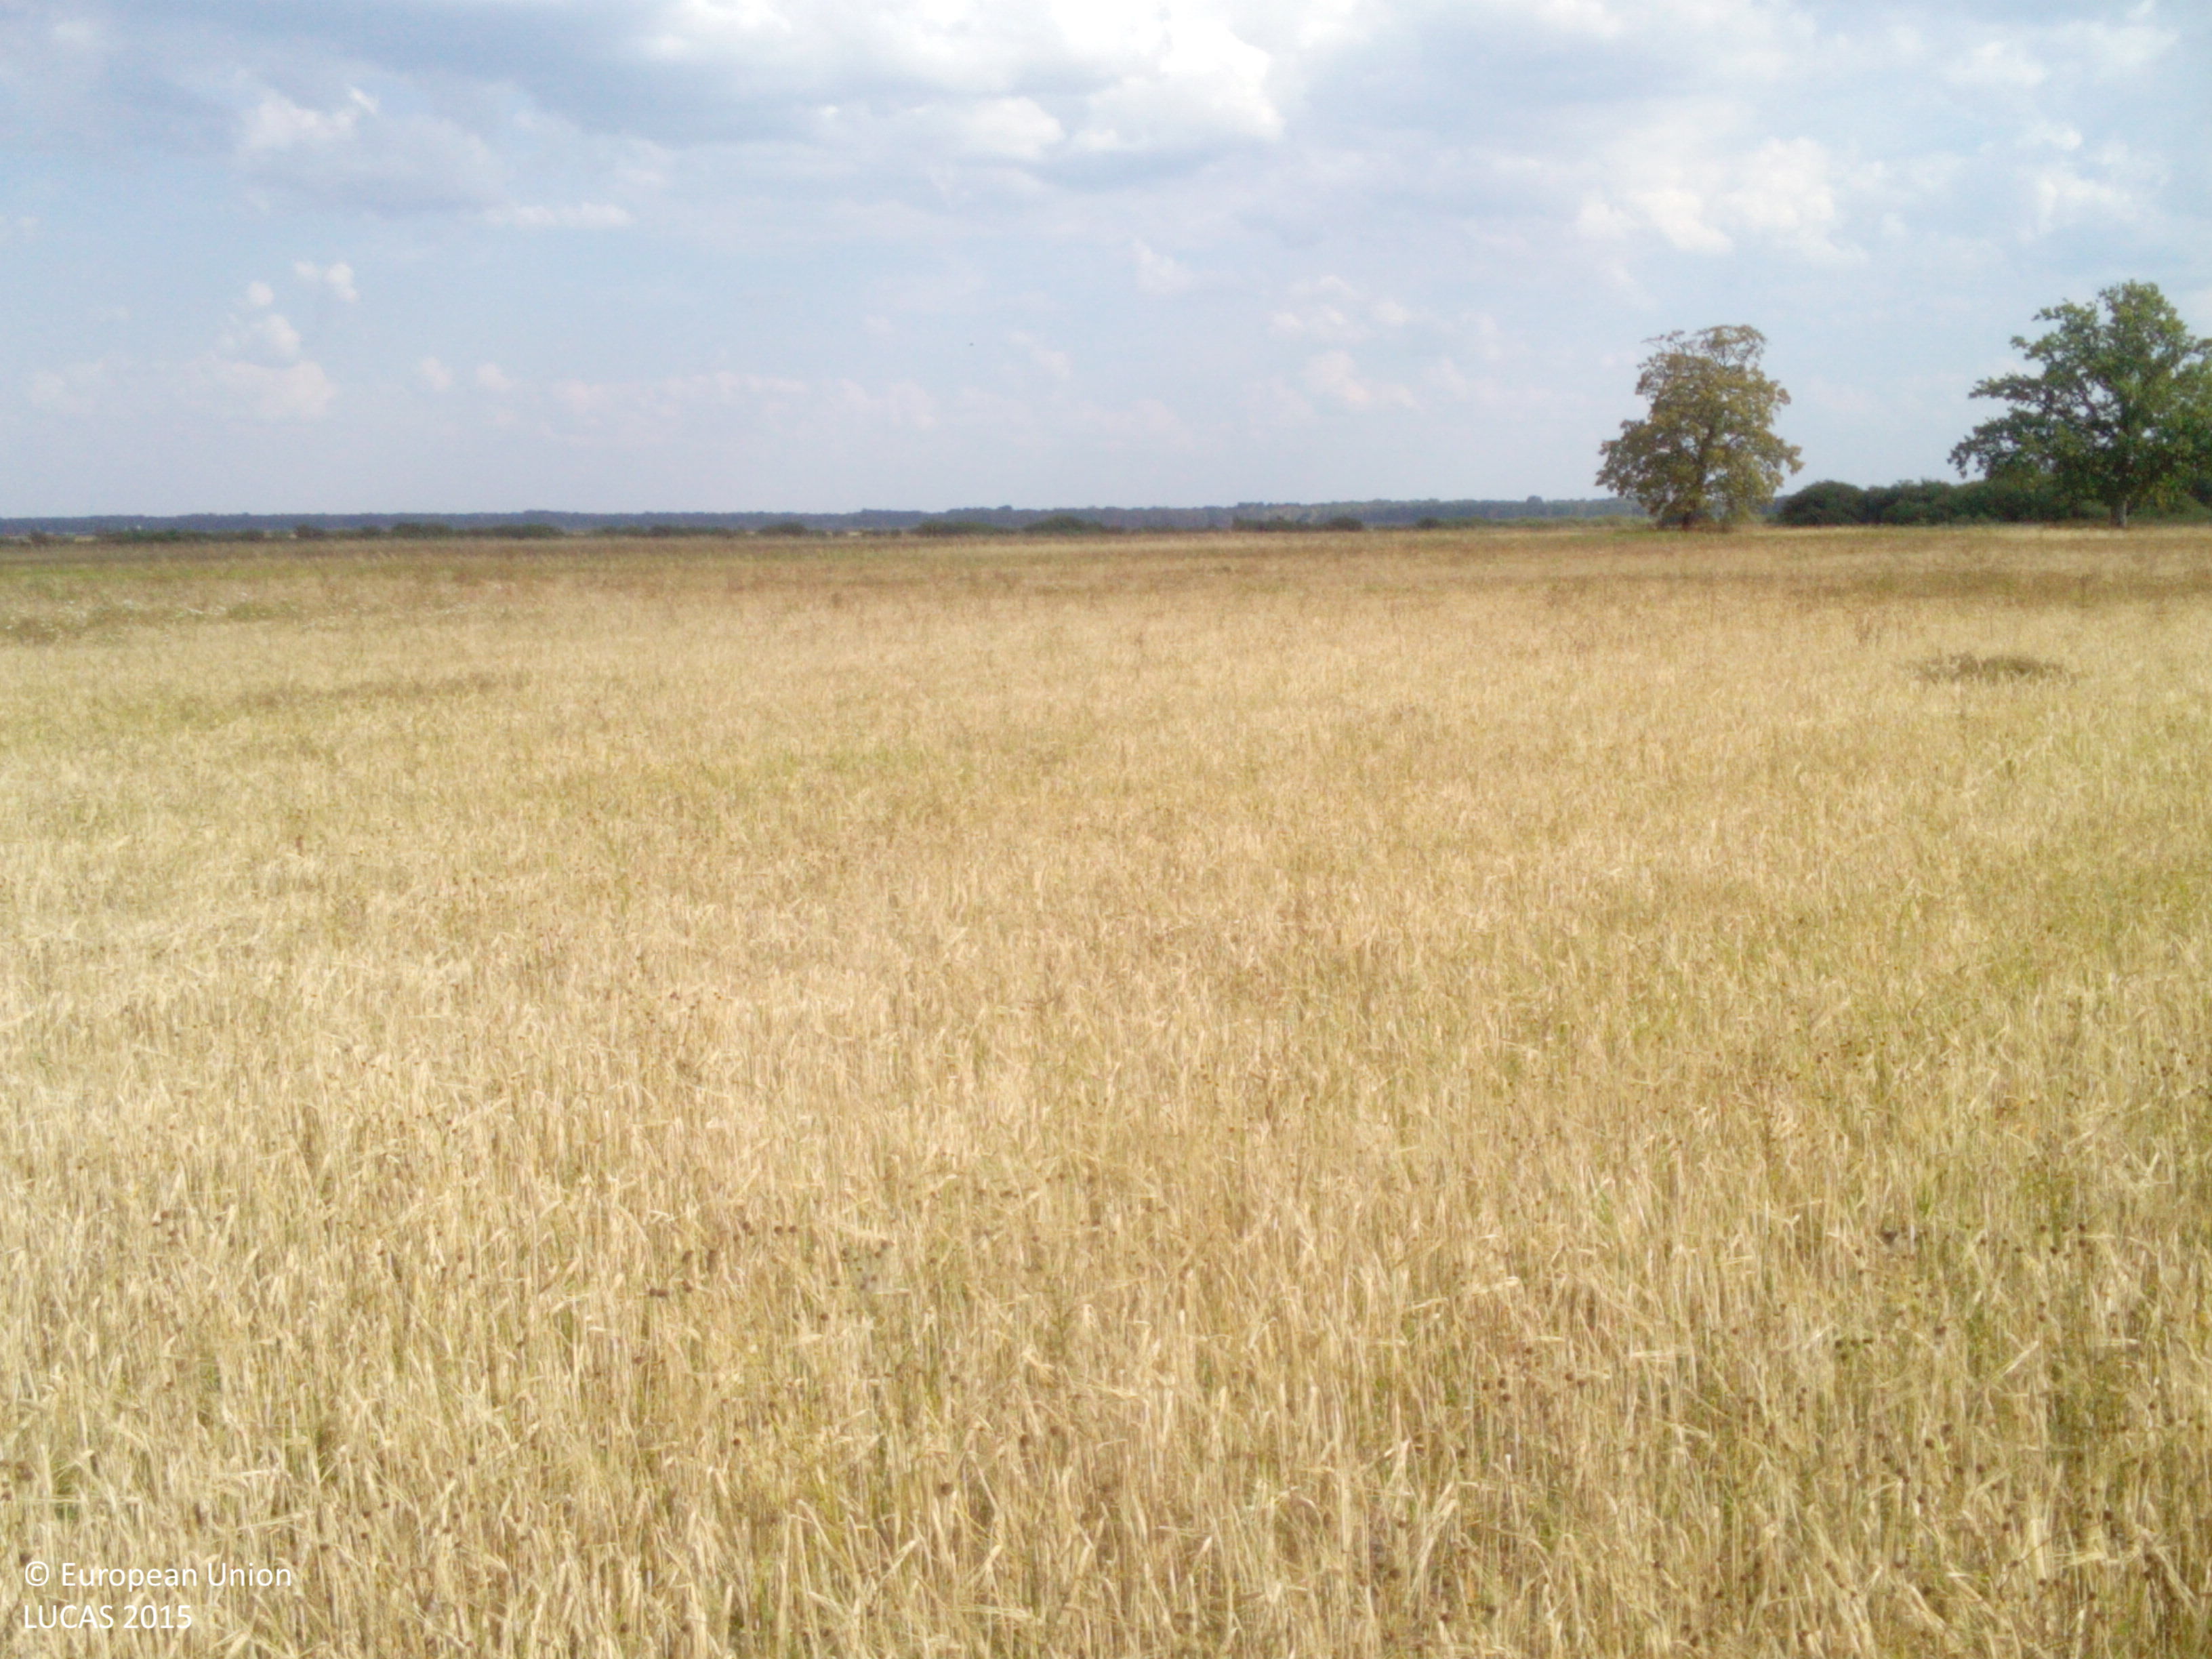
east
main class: Cropland
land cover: Barley
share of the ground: > 75 %
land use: Agriculture (excluding fallow land and kitchen gardens)
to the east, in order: Barley
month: August
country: LV
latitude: 56.2912
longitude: 21.0396
